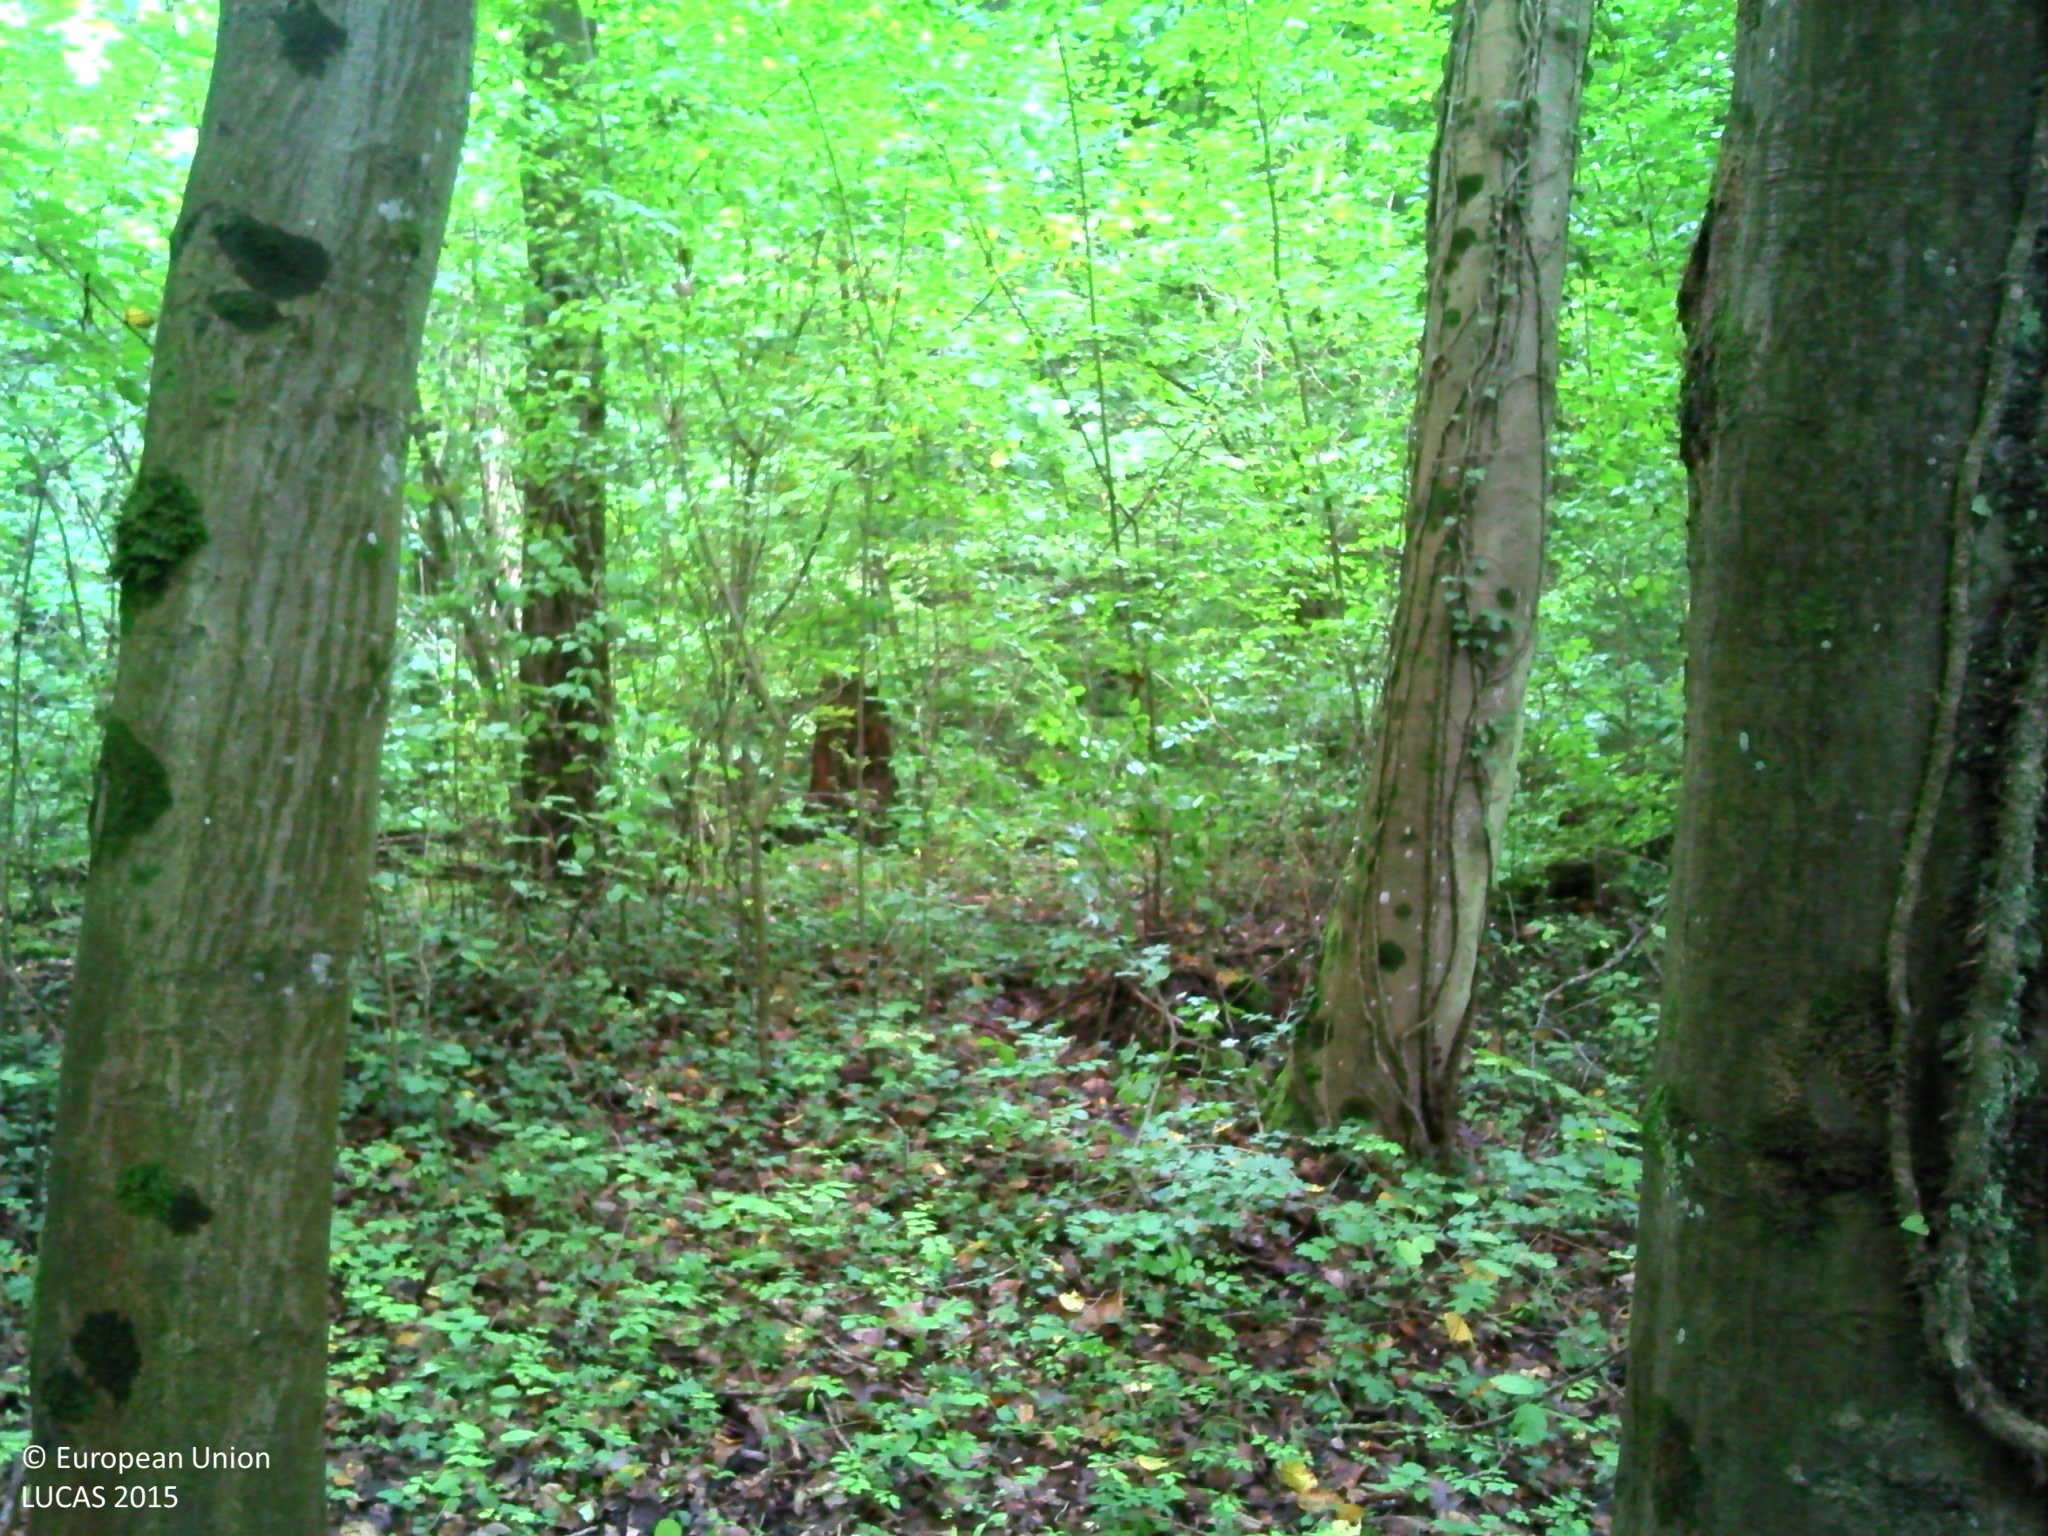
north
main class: Woodland
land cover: Broadleaved woodland
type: mesophytic deciduous forest
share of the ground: > 75 %
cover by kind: broadleaved forest trees 90 %, herbaceous plants 5 %, consolidated bare surface 5 %
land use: Forestry
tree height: > 5 m
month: September
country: FR
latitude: 48.8727
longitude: 6.0322
